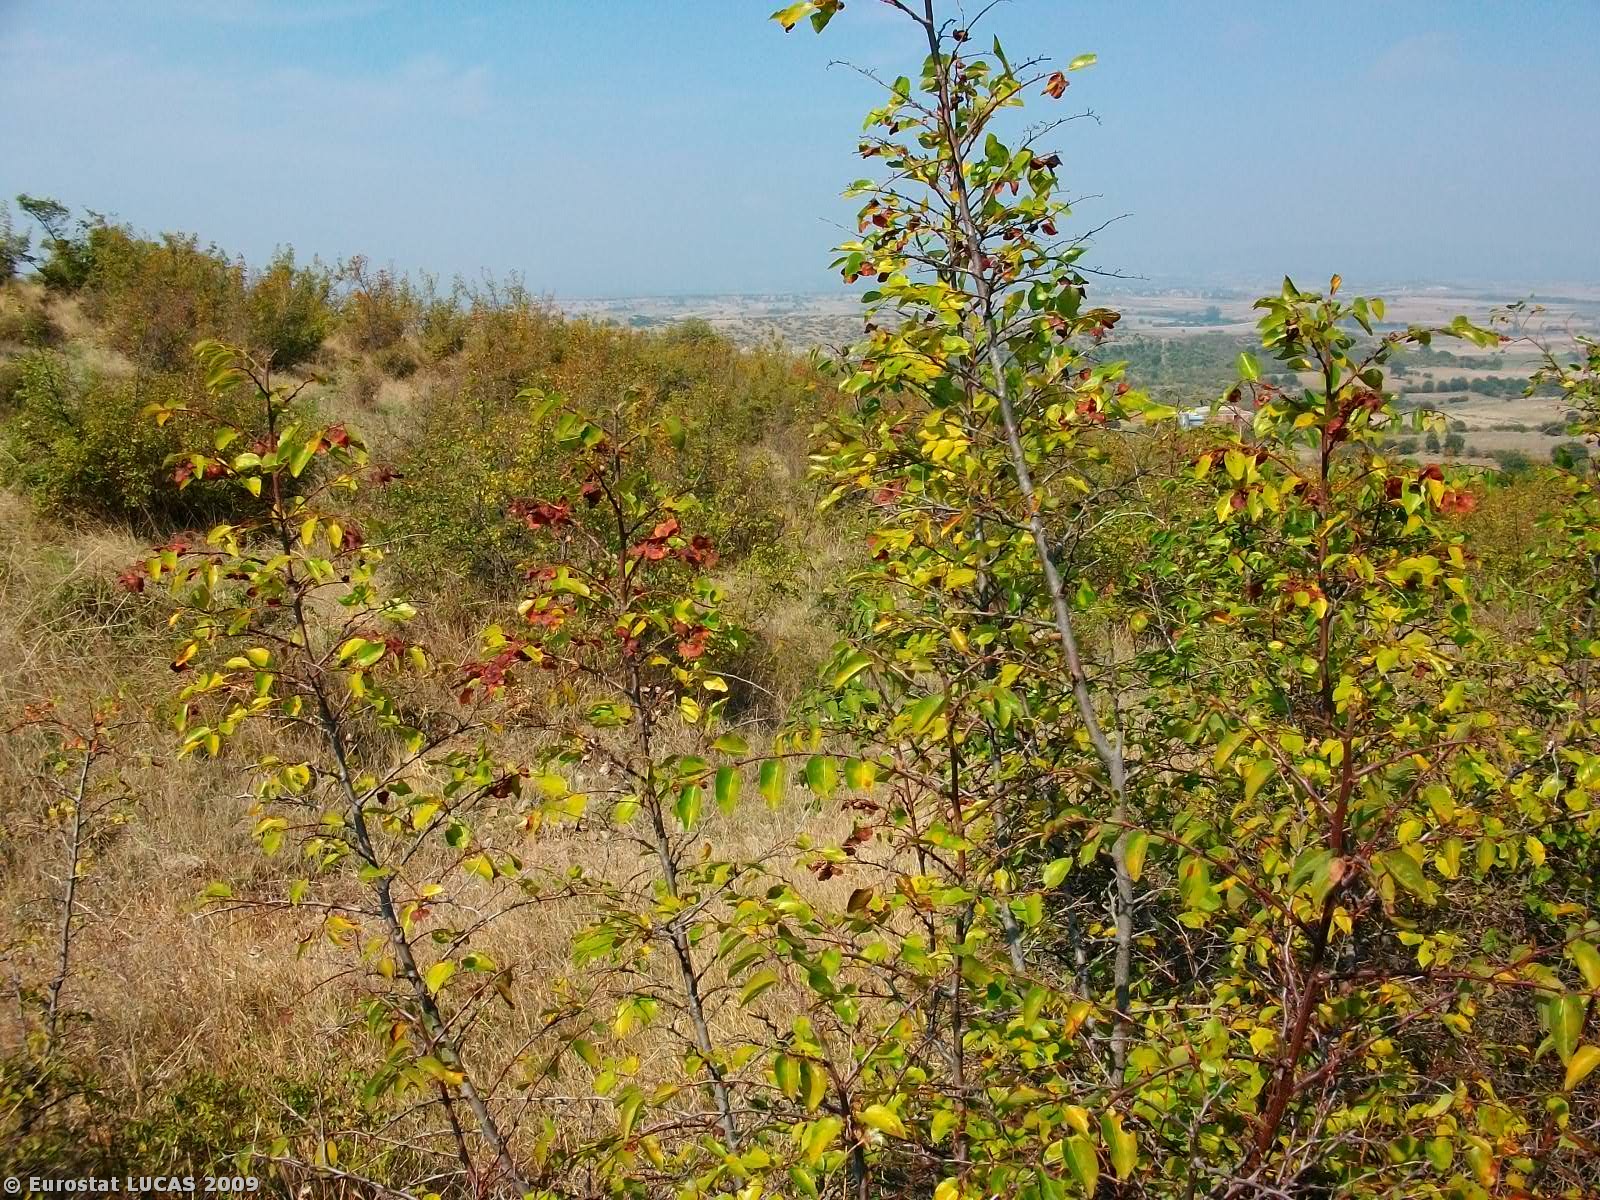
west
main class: Shrubland
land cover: Shrubland without tree cover
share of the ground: 50 - 75 %
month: September
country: GR
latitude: 40.9581
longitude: 26.2837
